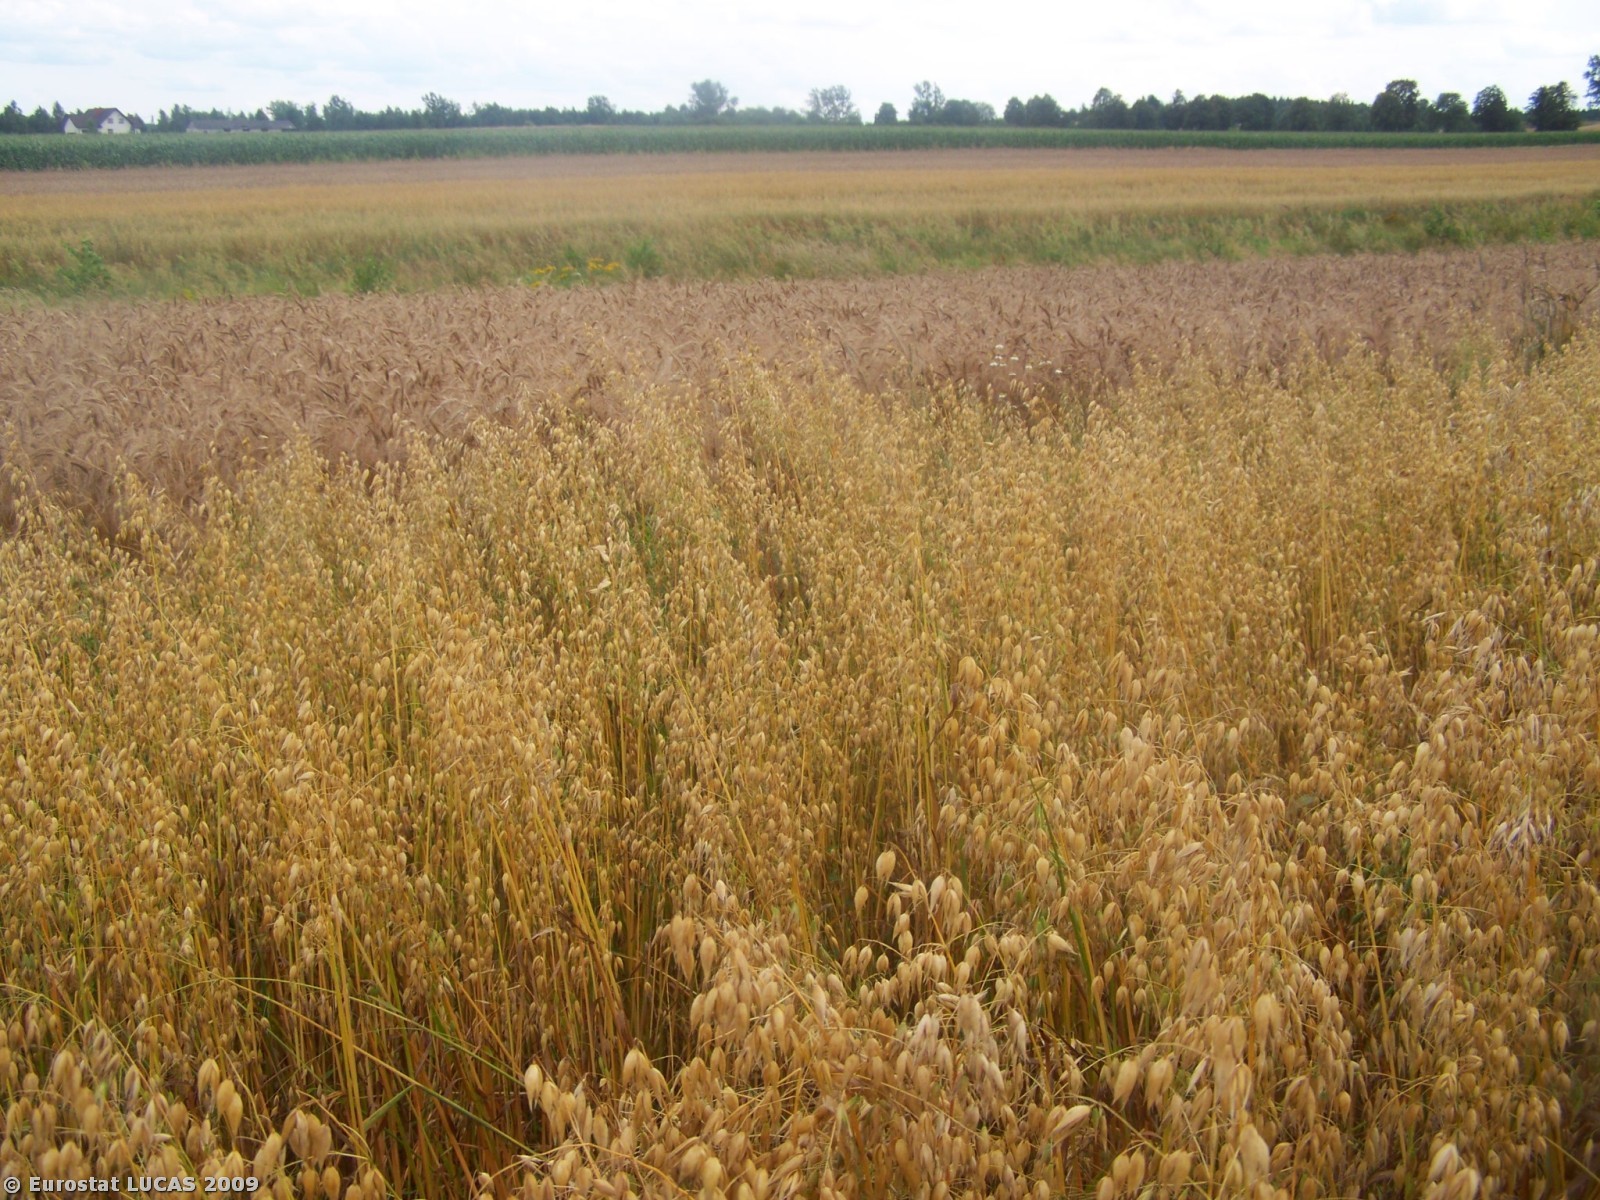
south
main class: Cropland
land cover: Oats
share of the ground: > 75 %
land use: Agriculture (excluding fallow land and kitchen gardens)
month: July
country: PL
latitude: 51.5574
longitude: 21.5475
